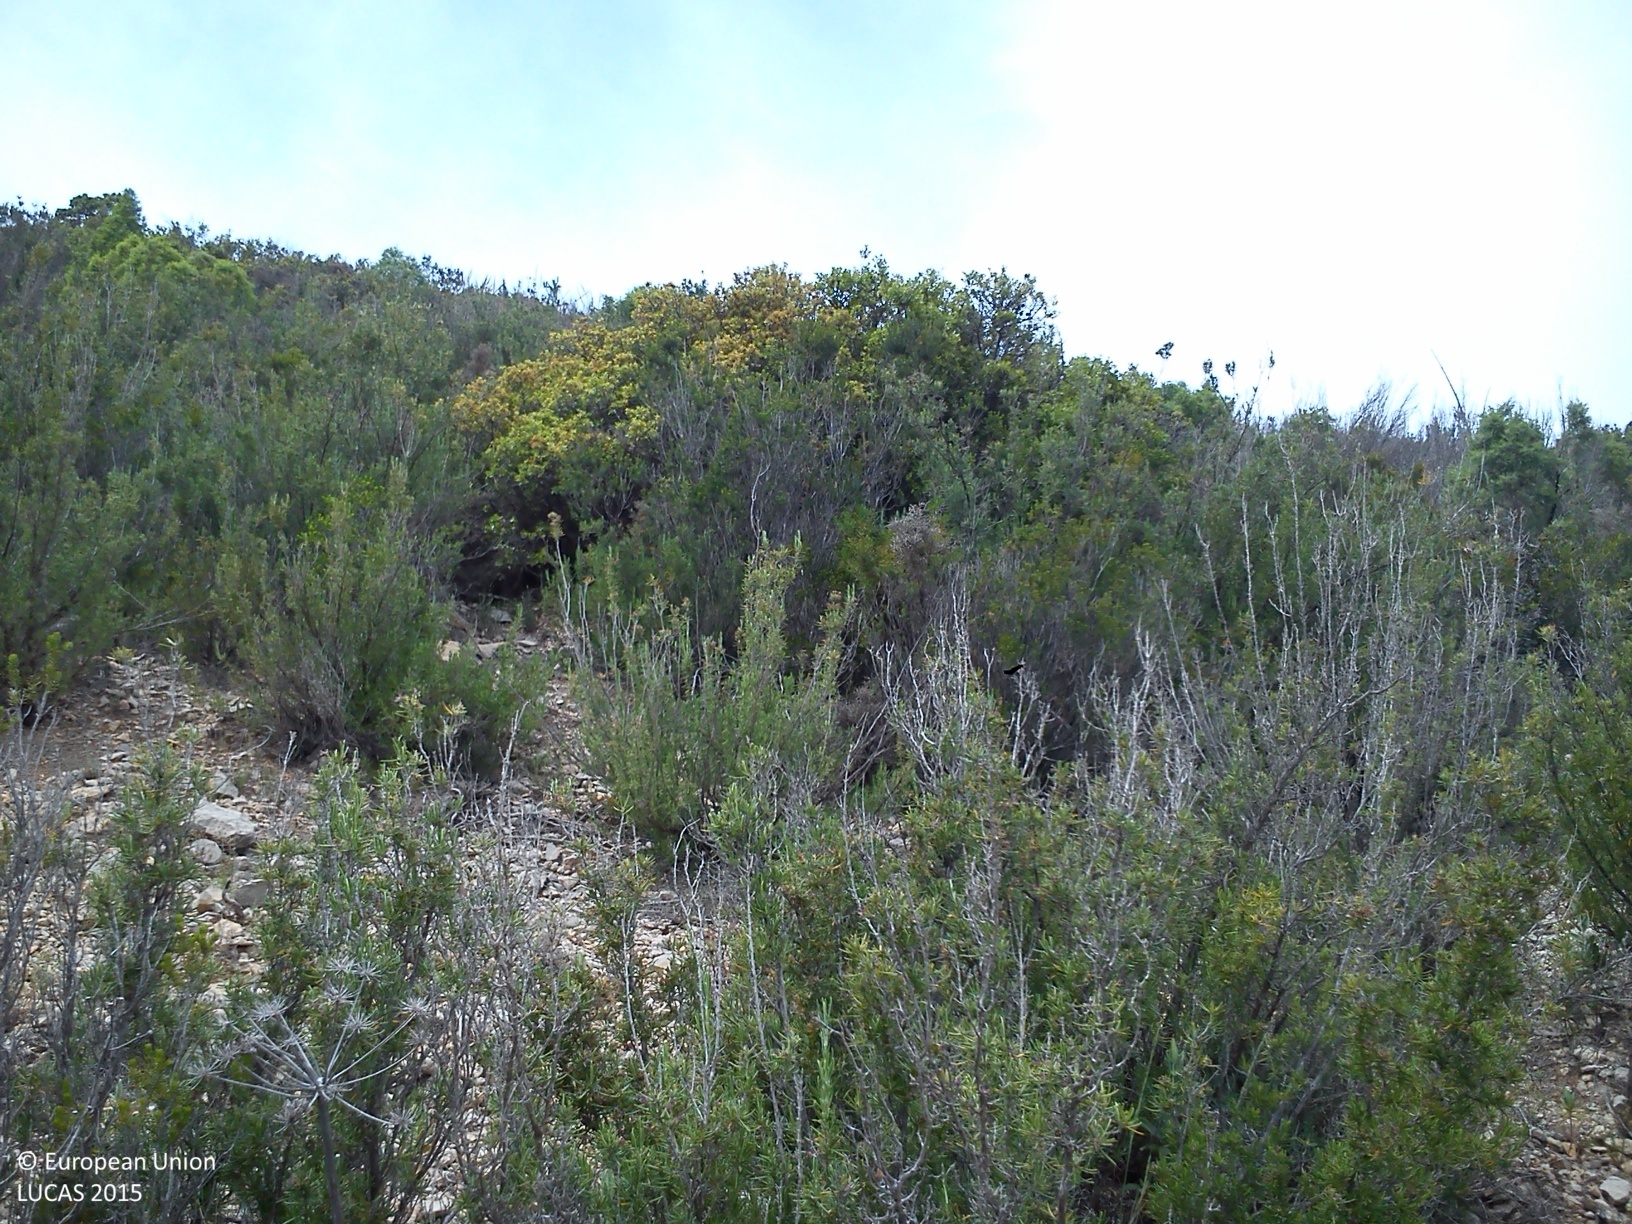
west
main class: Shrubland
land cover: Shrubland without tree cover
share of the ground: > 75 %
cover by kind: shrubs 80 %, herbaceous plants 10 %, consolidated bare surface 10 %
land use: Semi-natural and natural areas not in use
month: May
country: ES
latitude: 39.6709
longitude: -0.9488
